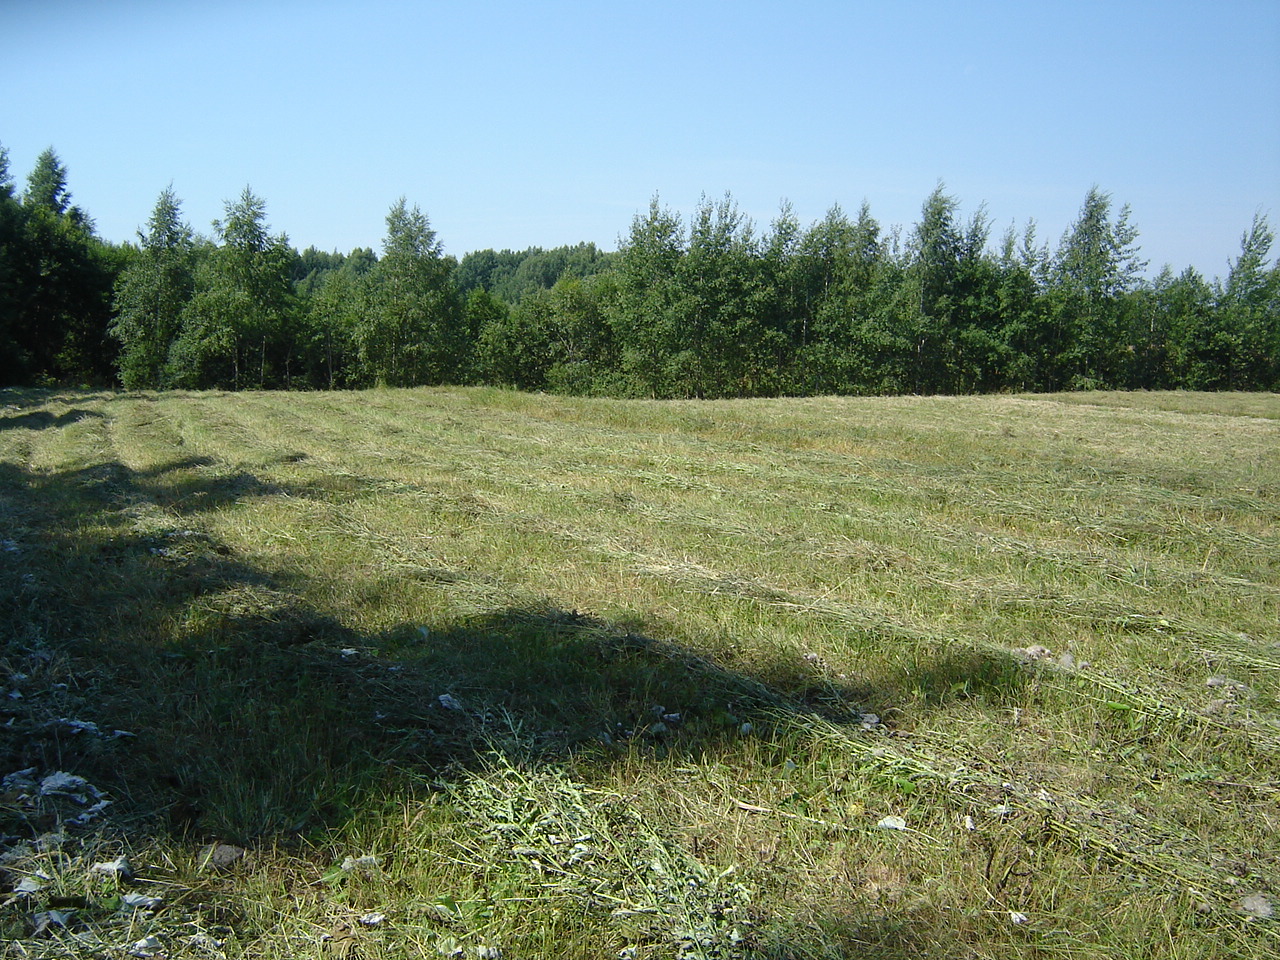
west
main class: Grassland
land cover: Grassland without tree/shrub cover
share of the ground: > 75 %
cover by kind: herbaceous plants 100 %
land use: Agriculture (excluding fallow land and kitchen gardens)
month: August
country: LT
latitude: 55.2078
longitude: 24.9942
